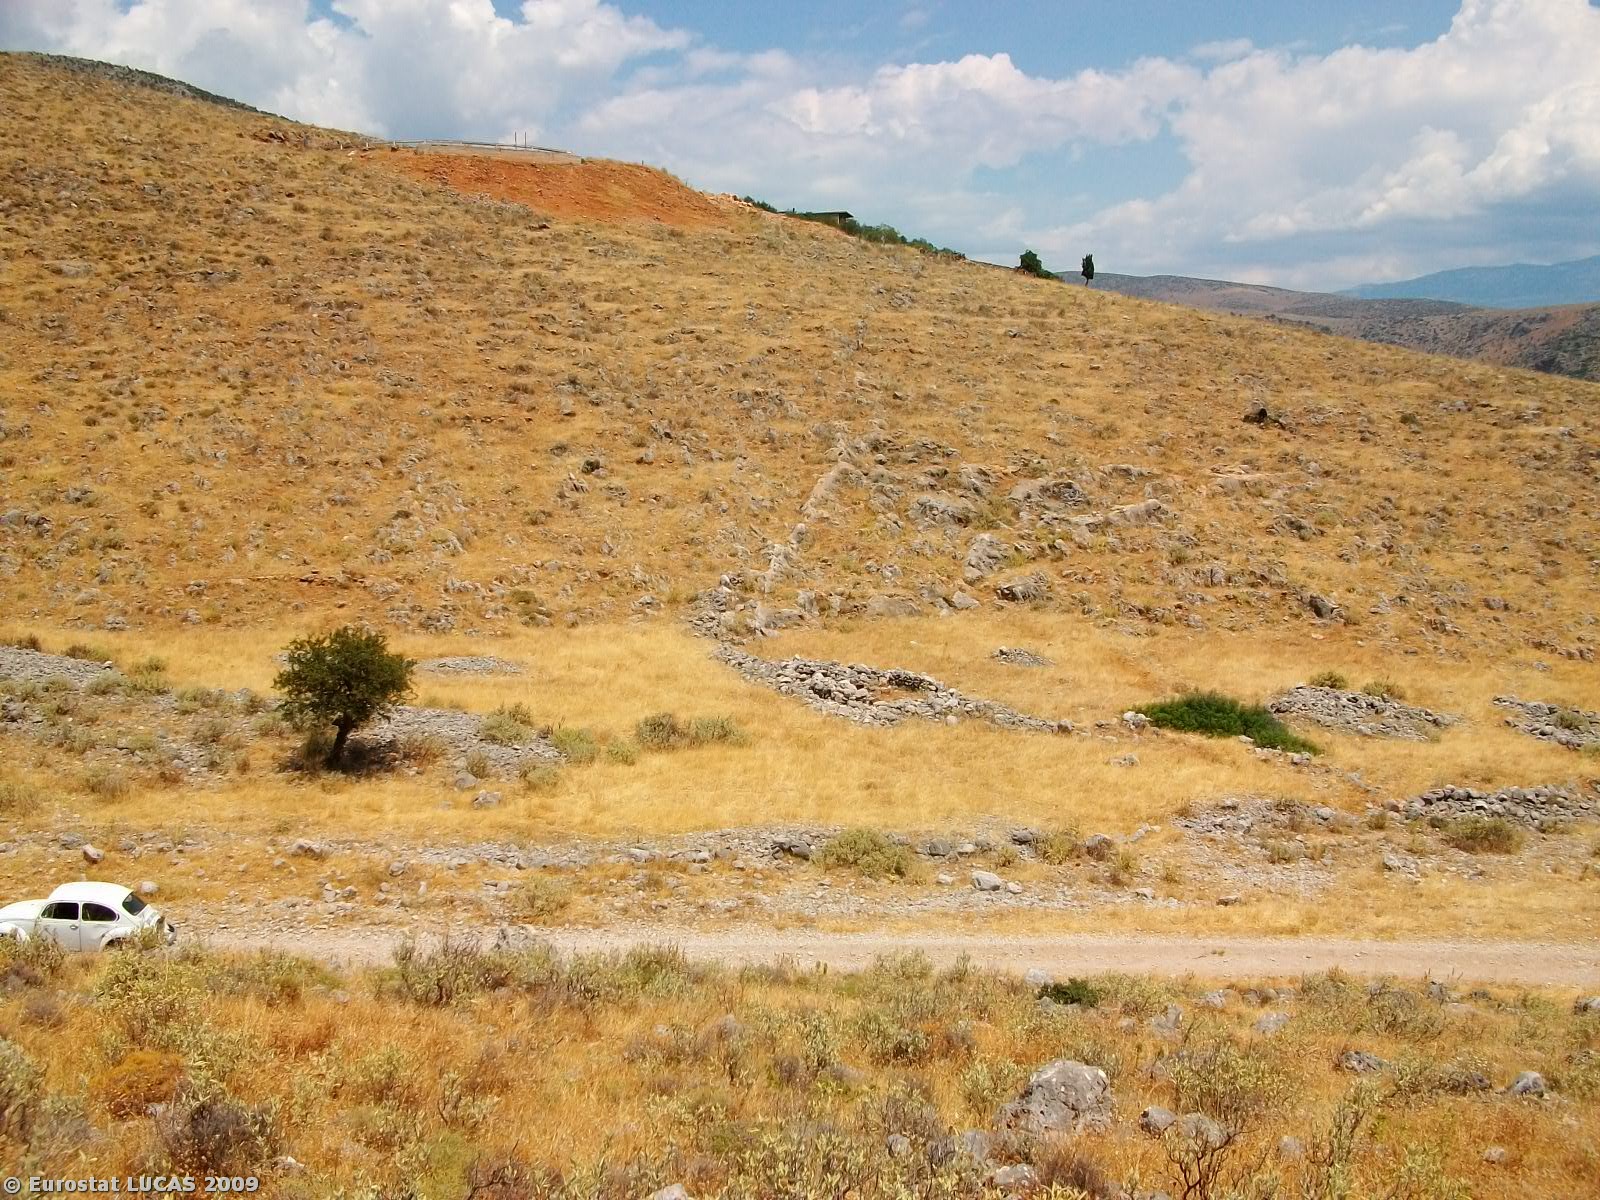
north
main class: Shrubland
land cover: Shrubland without tree cover
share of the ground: > 75 %
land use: Agriculture (excluding fallow land and kitchen gardens)
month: July
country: GR
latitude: 38.4042
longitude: 22.3524
